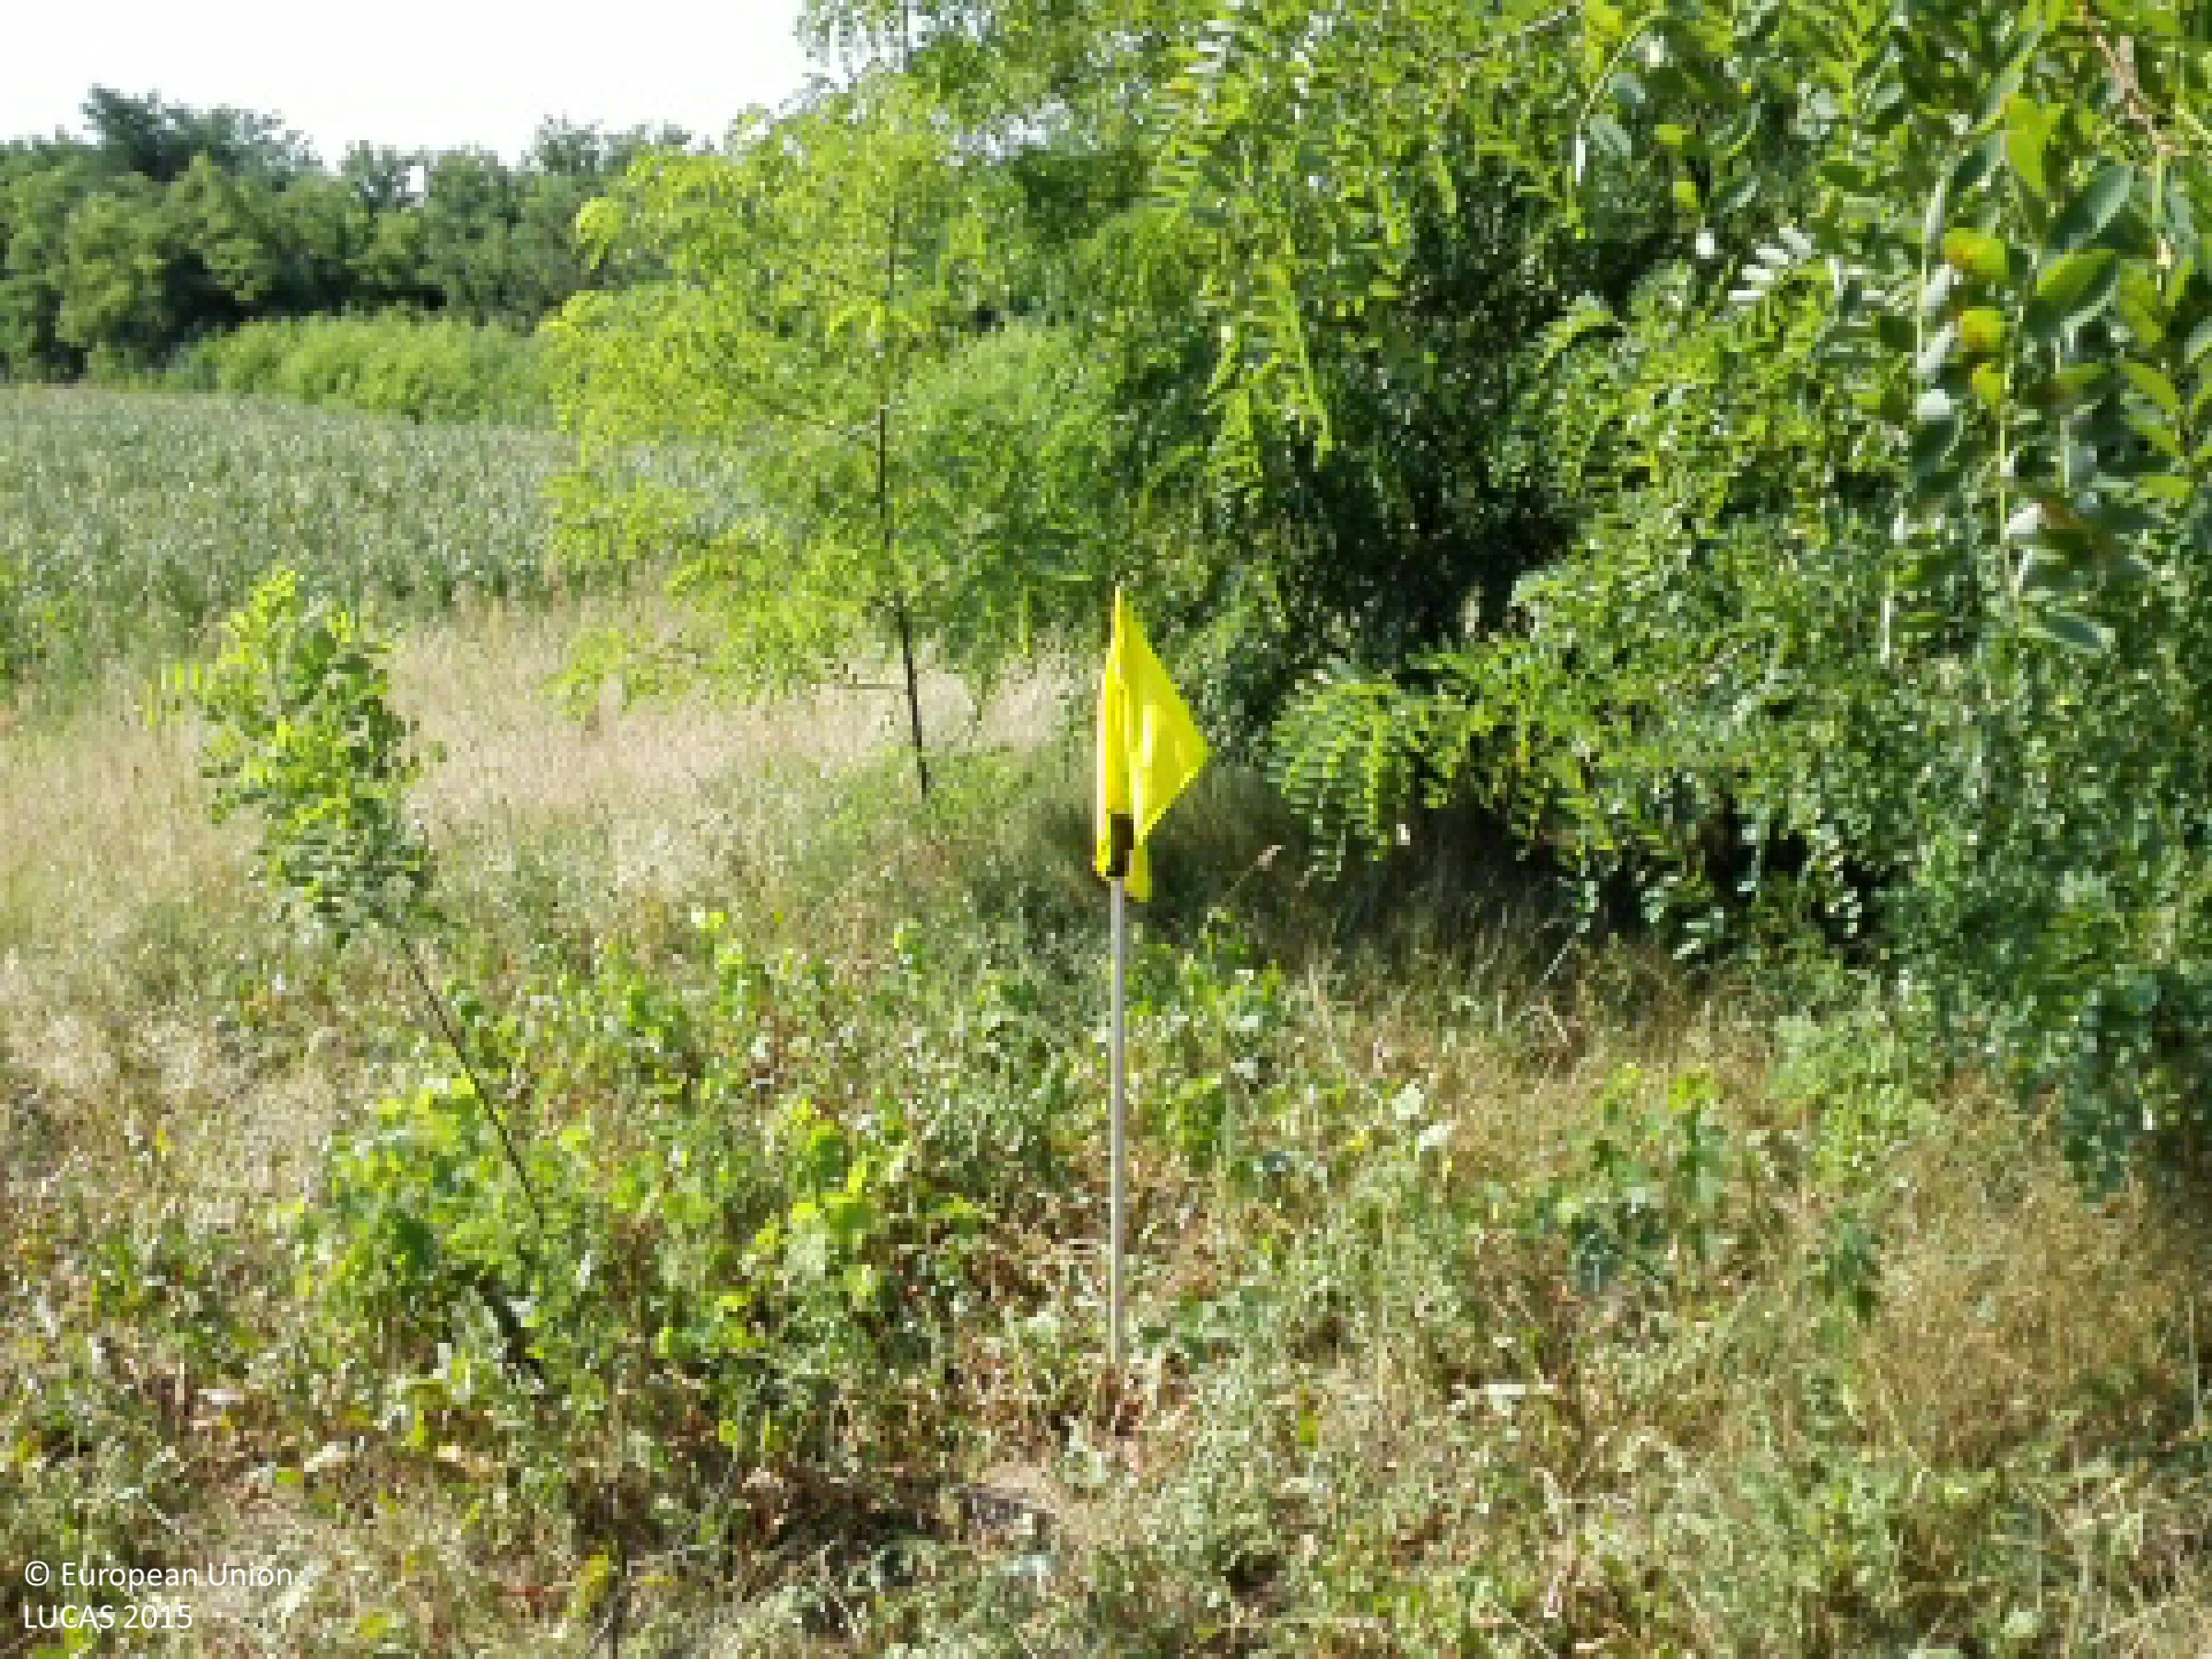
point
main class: Woodland
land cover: Broadleaved woodland
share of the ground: > 75 %
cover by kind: broadleaved forest trees 40 %, shrubs 30 %, herbaceous plants 30 %
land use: Semi-natural and natural areas not in use
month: July
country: HU
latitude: 47.6943
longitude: 21.6512
